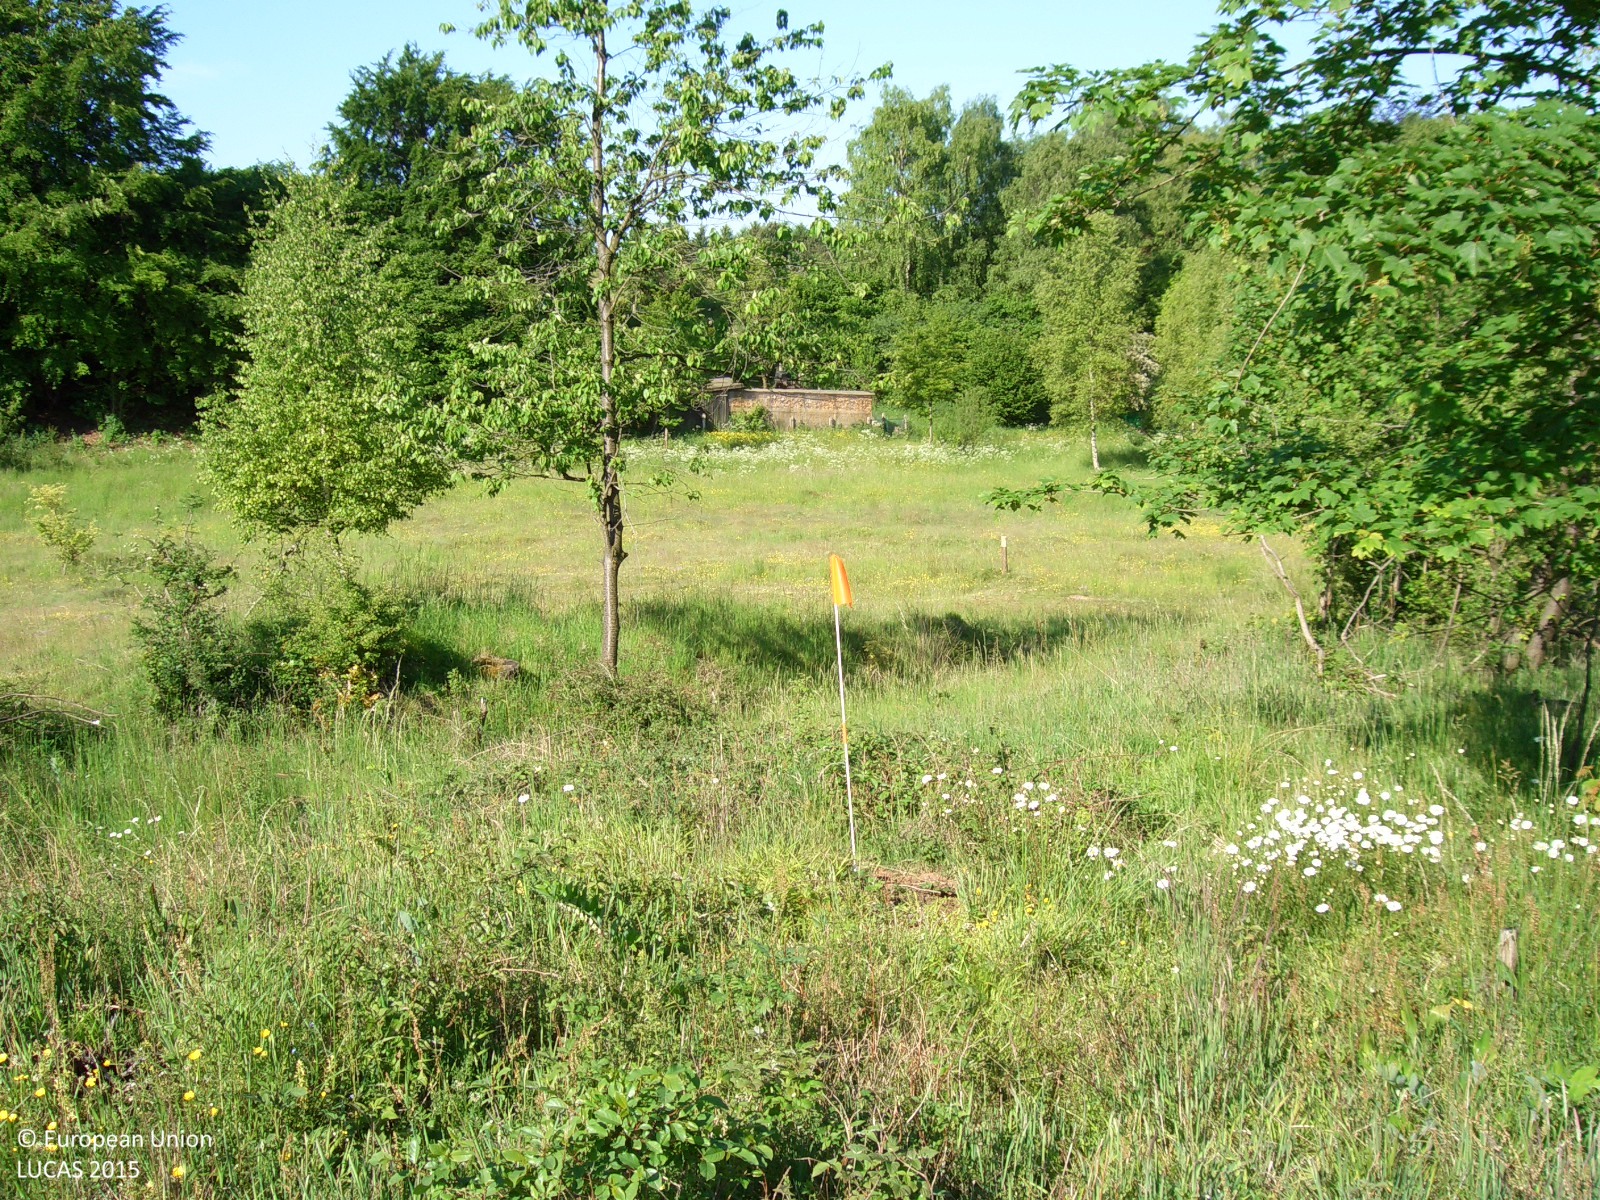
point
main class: Woodland
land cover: Broadleaved woodland
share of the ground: 10 - 25 %
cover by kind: herbaceous plants 80 %, broadleaved forest trees 20 %
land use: Forestry
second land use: Amenities, museums, leisure
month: June
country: DE
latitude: 50.7344
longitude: 6.2446
